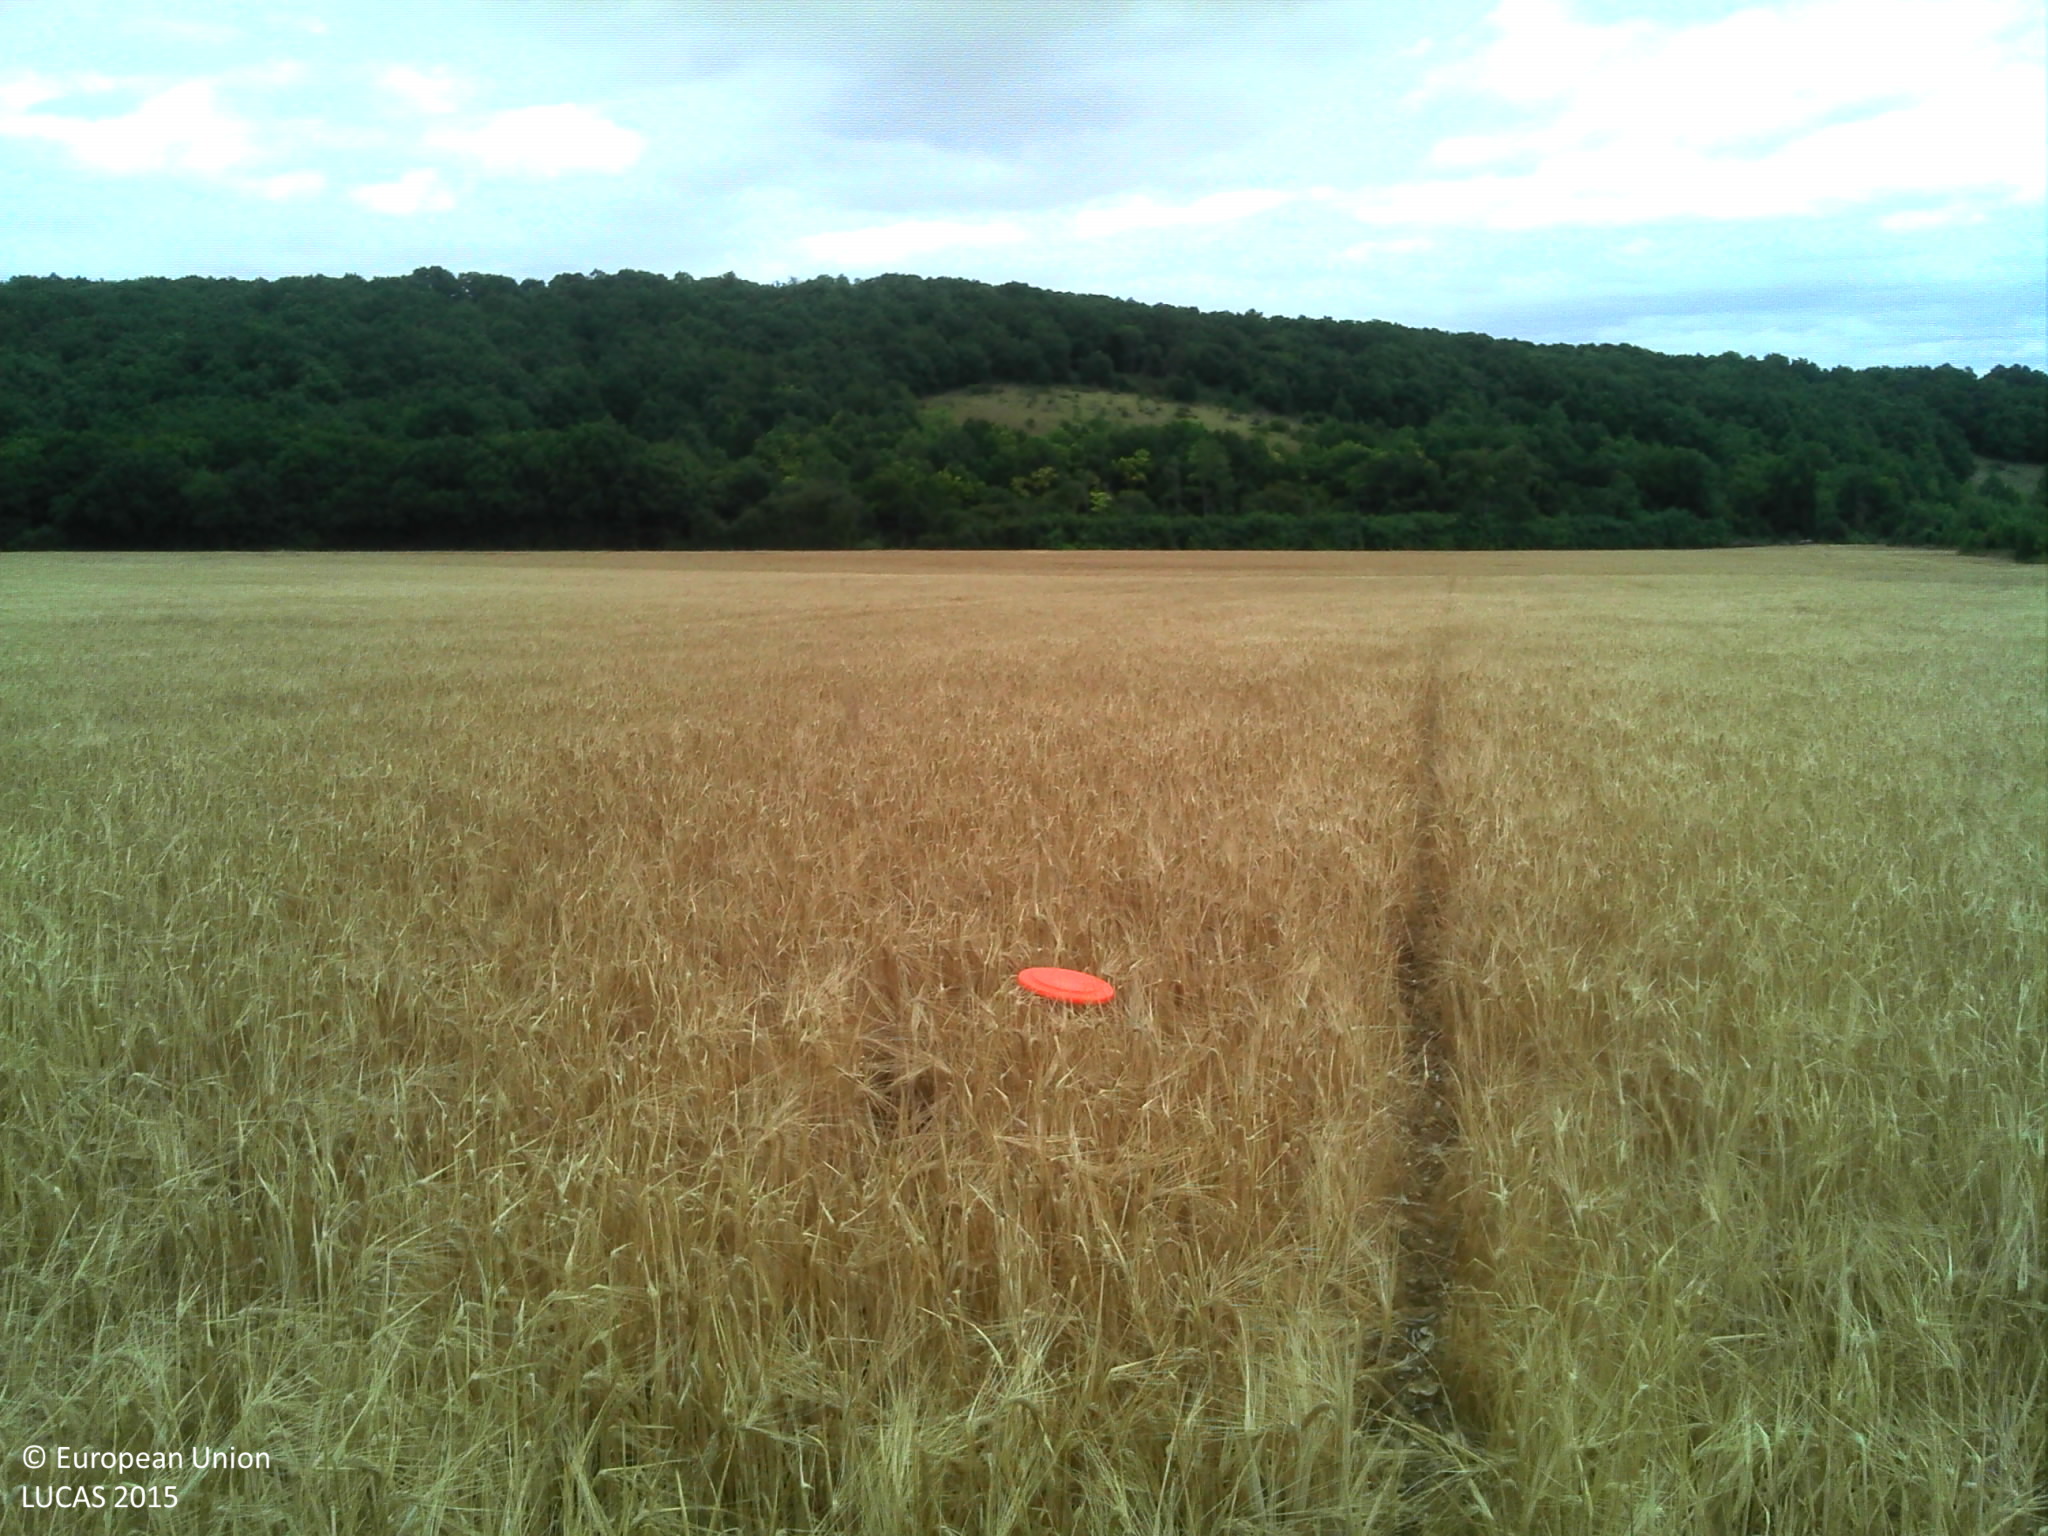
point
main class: Cropland
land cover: Barley
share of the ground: > 75 %
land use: Agriculture (excluding fallow land and kitchen gardens)
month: July
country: FR
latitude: 48.1892
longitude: 3.4163
